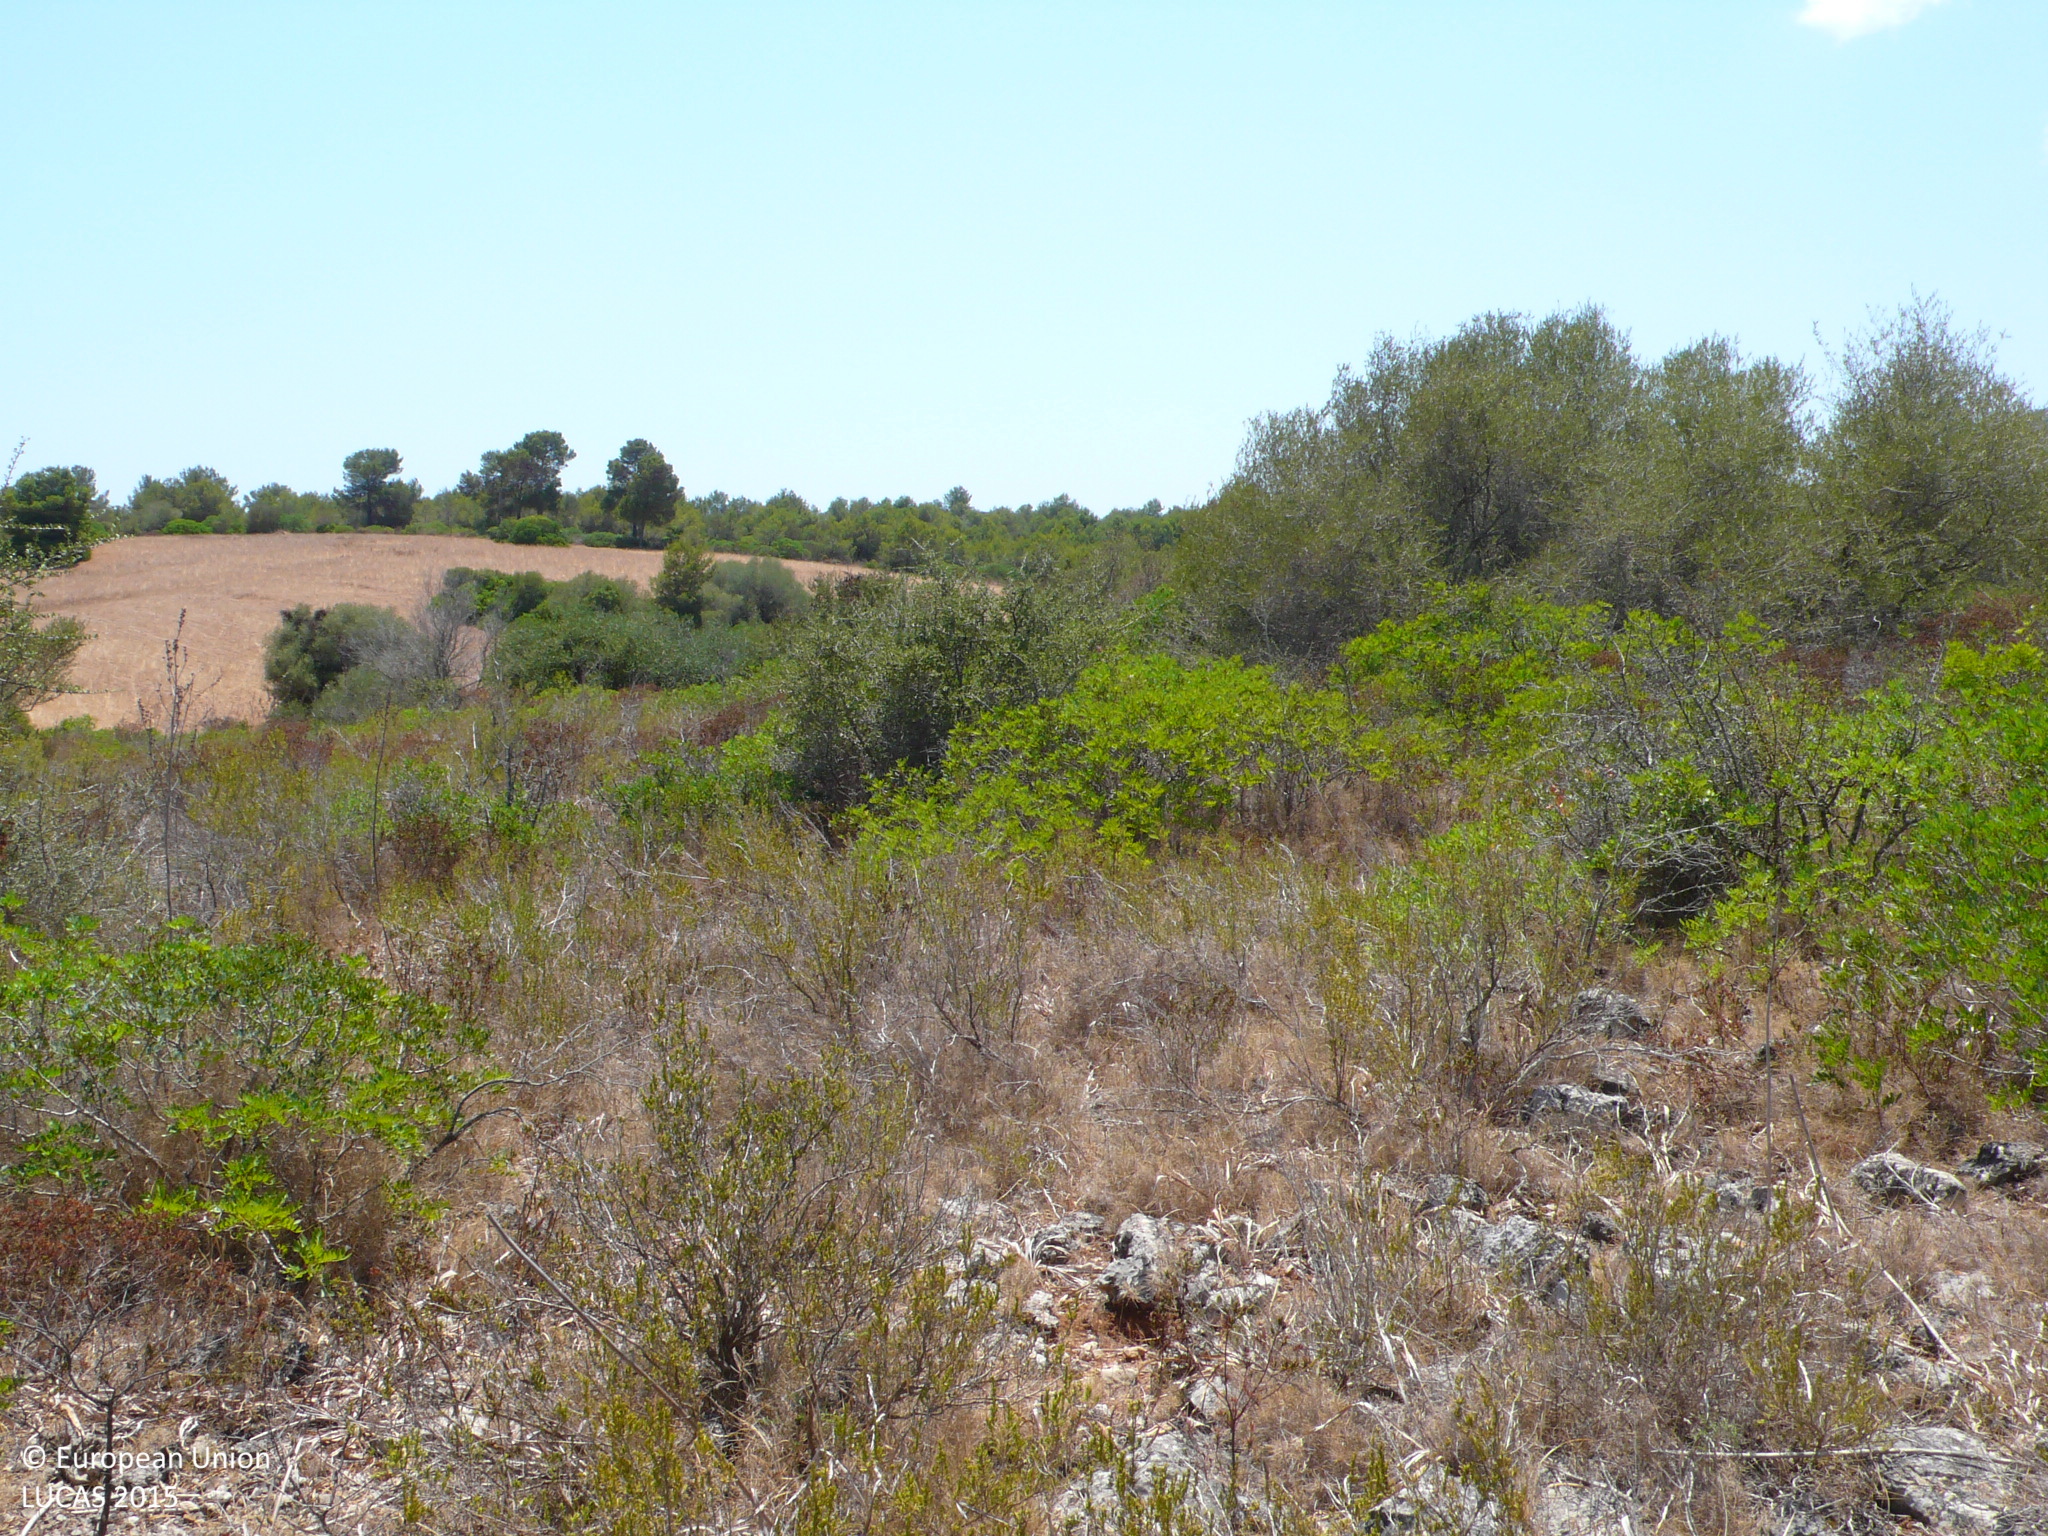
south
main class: Woodland
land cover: Pine dominated mixed woodland
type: coniferous forest of the mediterranean region
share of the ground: 50 - 75 %
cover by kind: shrubs 40 %, coniferous forest trees 35 %, broadleaved forest trees 15 %, consolidated bare surface 10 %
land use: Semi-natural and natural areas not in use
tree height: > 5 m
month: July
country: ES
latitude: 39.5276
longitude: 3.2711
